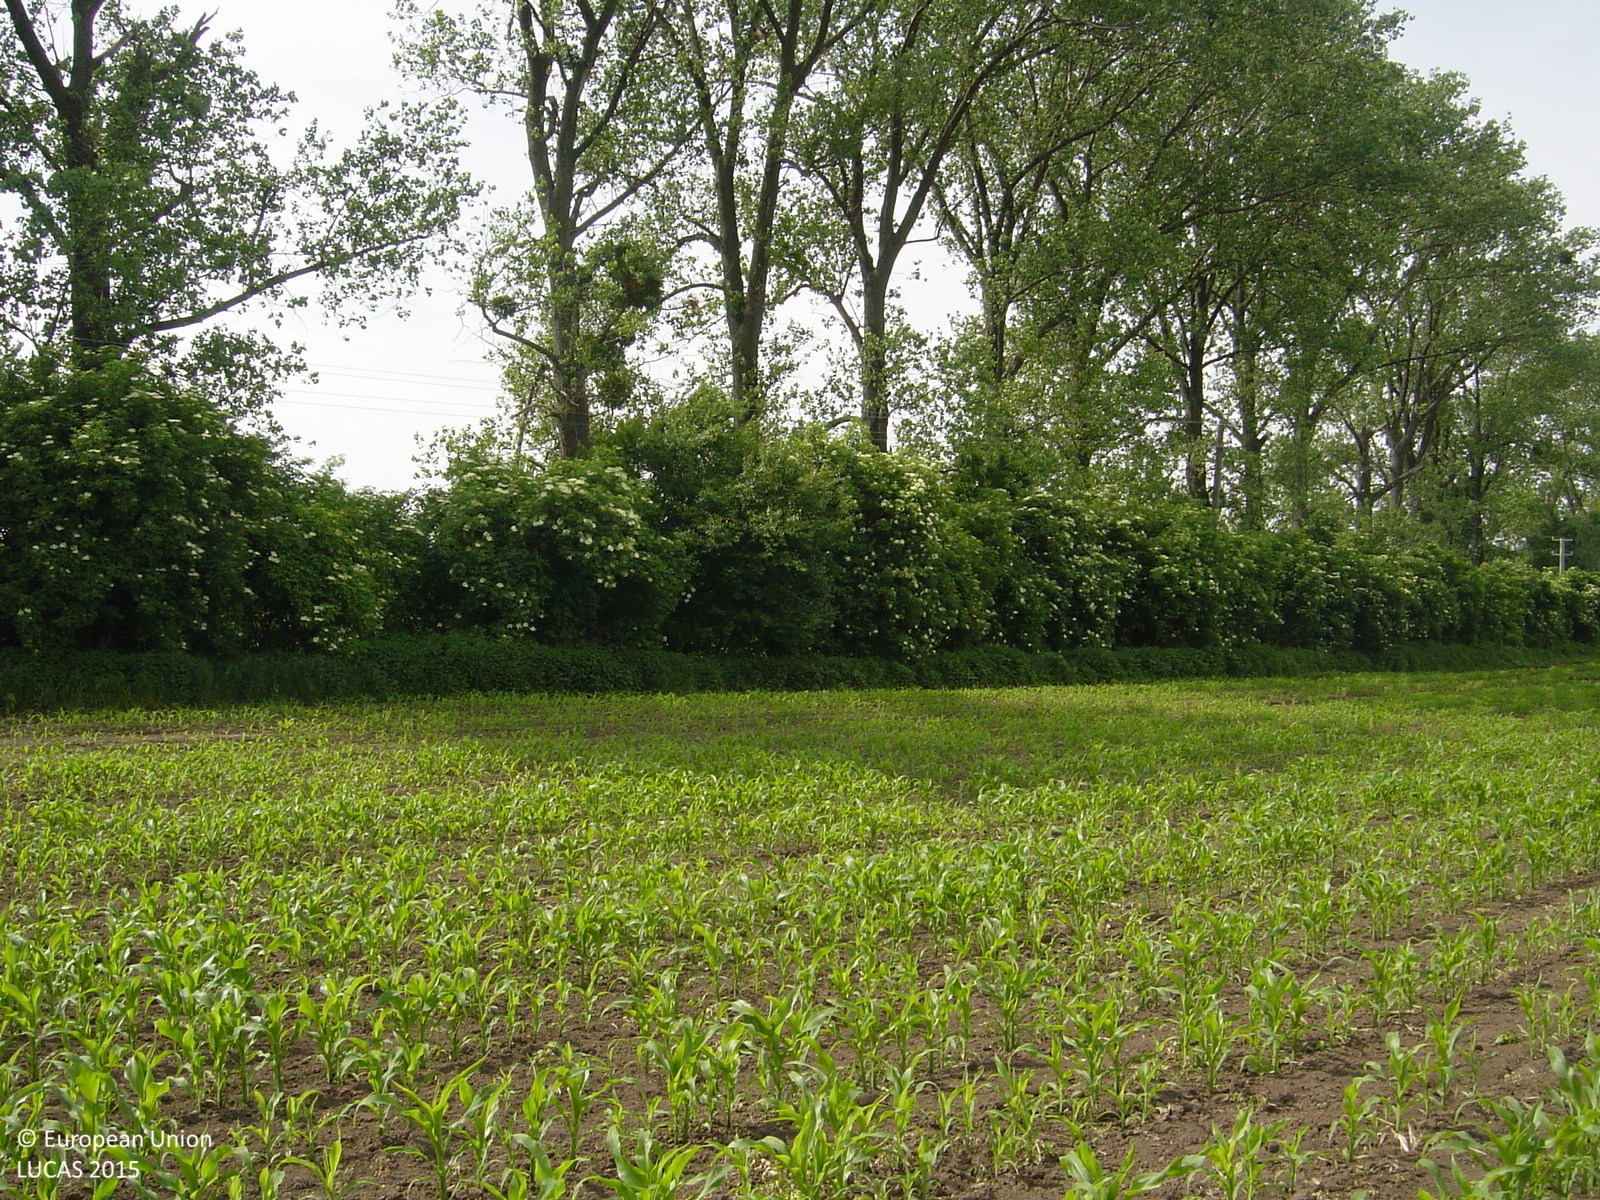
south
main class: Cropland
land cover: Maize
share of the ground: 25 - 50 %
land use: Agriculture (excluding fallow land and kitchen gardens)
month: June
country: CZ
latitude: 49.1701
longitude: 17.0730
